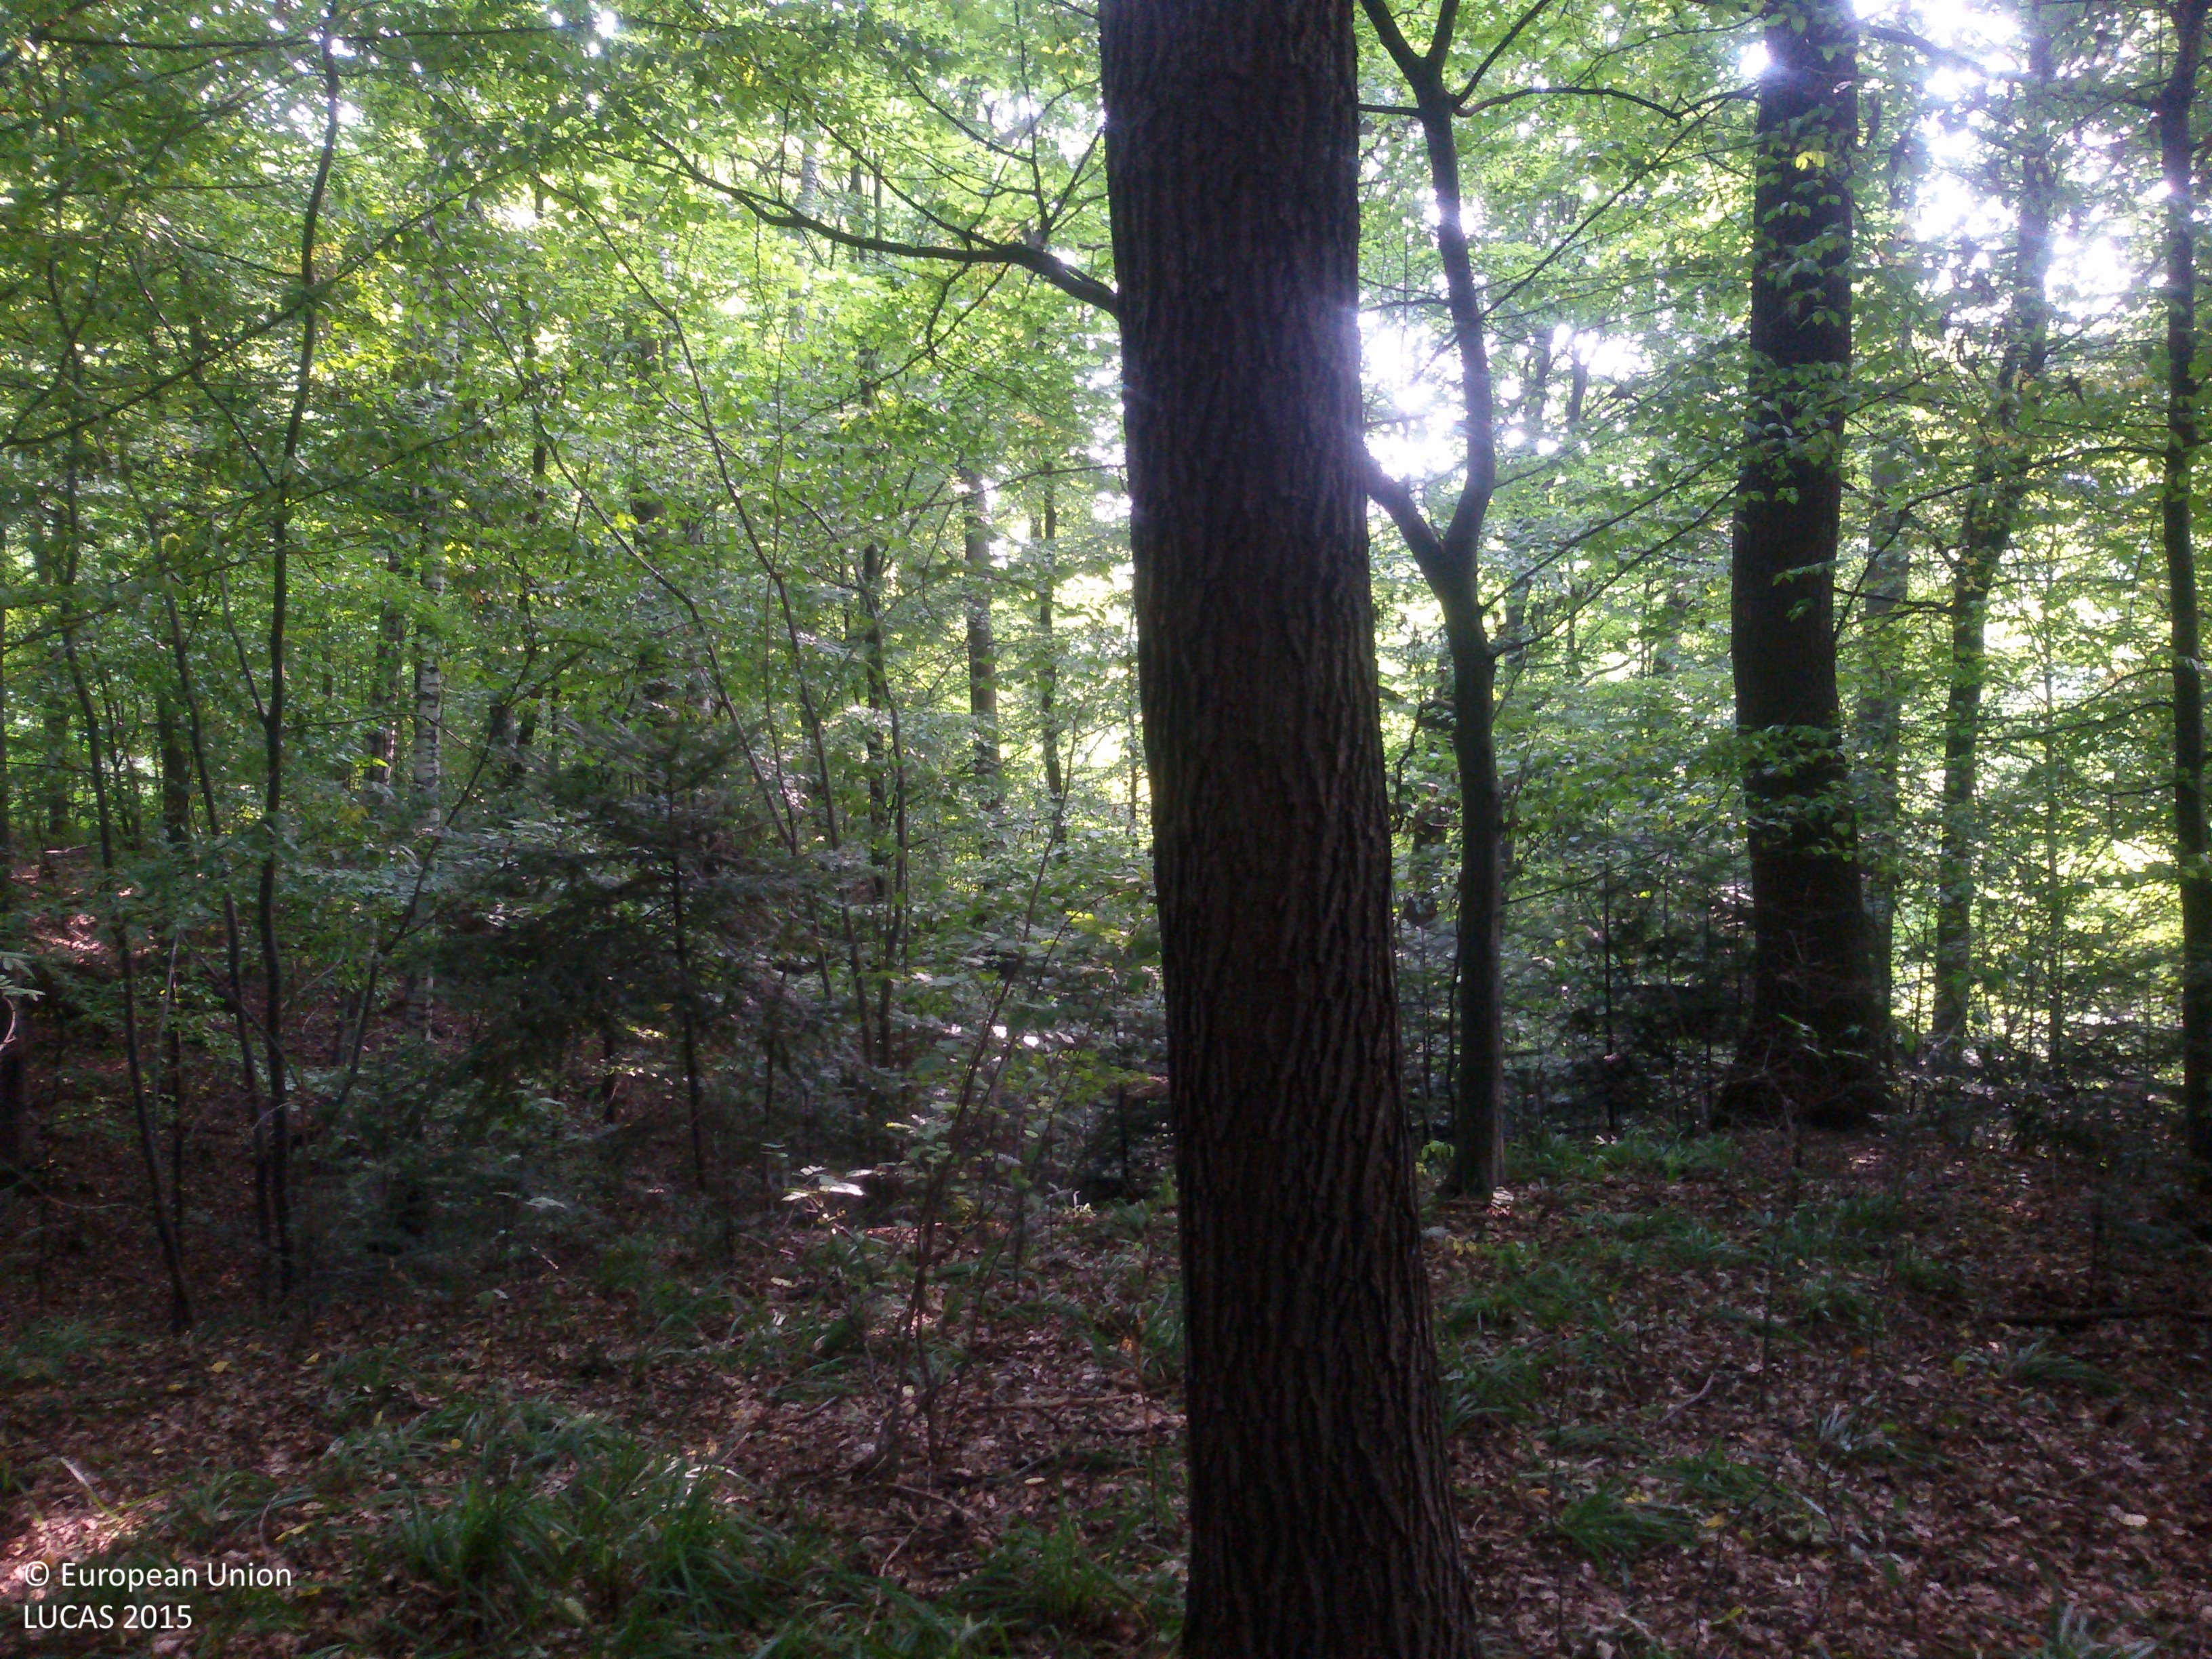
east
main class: Woodland
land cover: Broadleaved woodland
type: mesophytic deciduous forest
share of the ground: > 75 %
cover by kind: broadleaved forest trees 85 %, coniferous forest trees 5 %, shrubs 5 %, herbaceous plants 5 %
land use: Forestry
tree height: > 5 m
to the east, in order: Broadleaved woodland; Spontaneously vegetated surfaces; Broadleaved woodland; Rivers and streams; Other mixed woodland
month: August
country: PL
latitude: 49.8271
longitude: 20.2801
